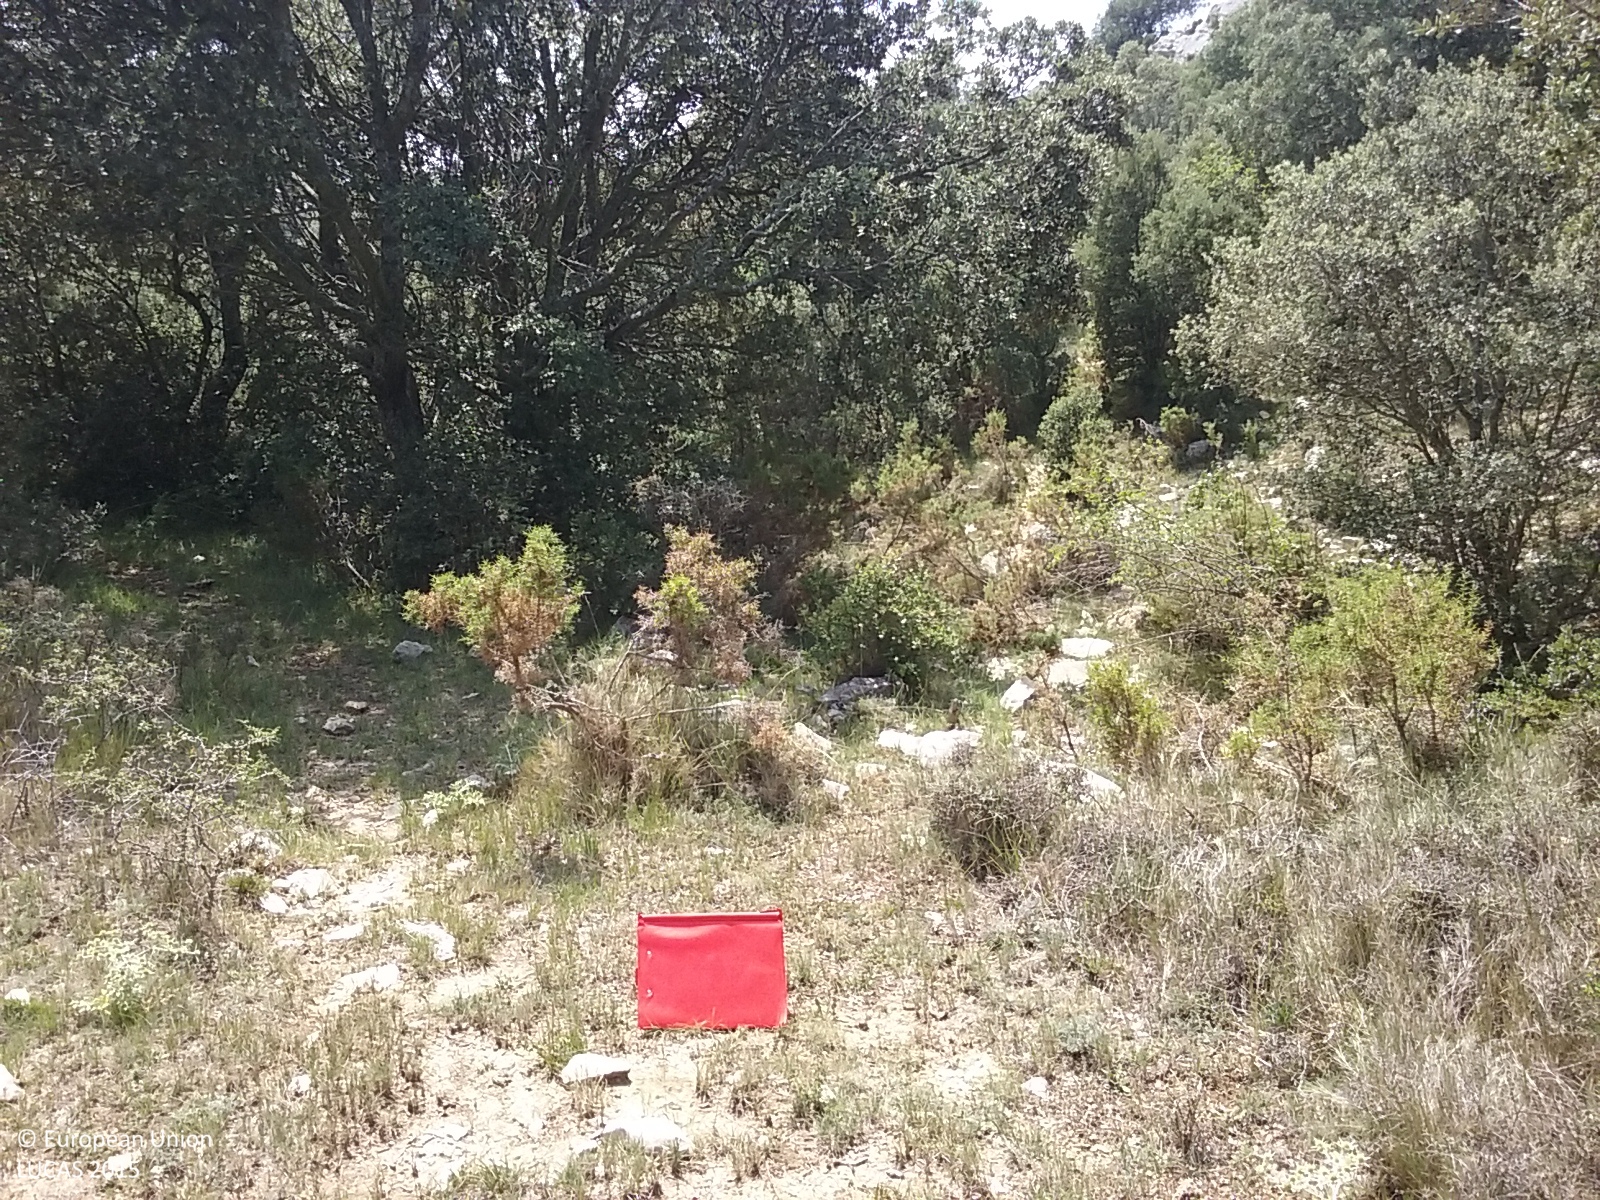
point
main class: Woodland
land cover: Broadleaved woodland
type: broadleaved evergreen forest
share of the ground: 50 - 75 %
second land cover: Shrubland without tree cover
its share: 25 - 50 %
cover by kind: broadleaved forest trees 60 %, shrubs 20 %, herbaceous plants 20 %
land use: Forestry
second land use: Agriculture (excluding fallow land and kitchen gardens)
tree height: > 5 m
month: August
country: ES
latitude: 40.4183
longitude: -0.1056
